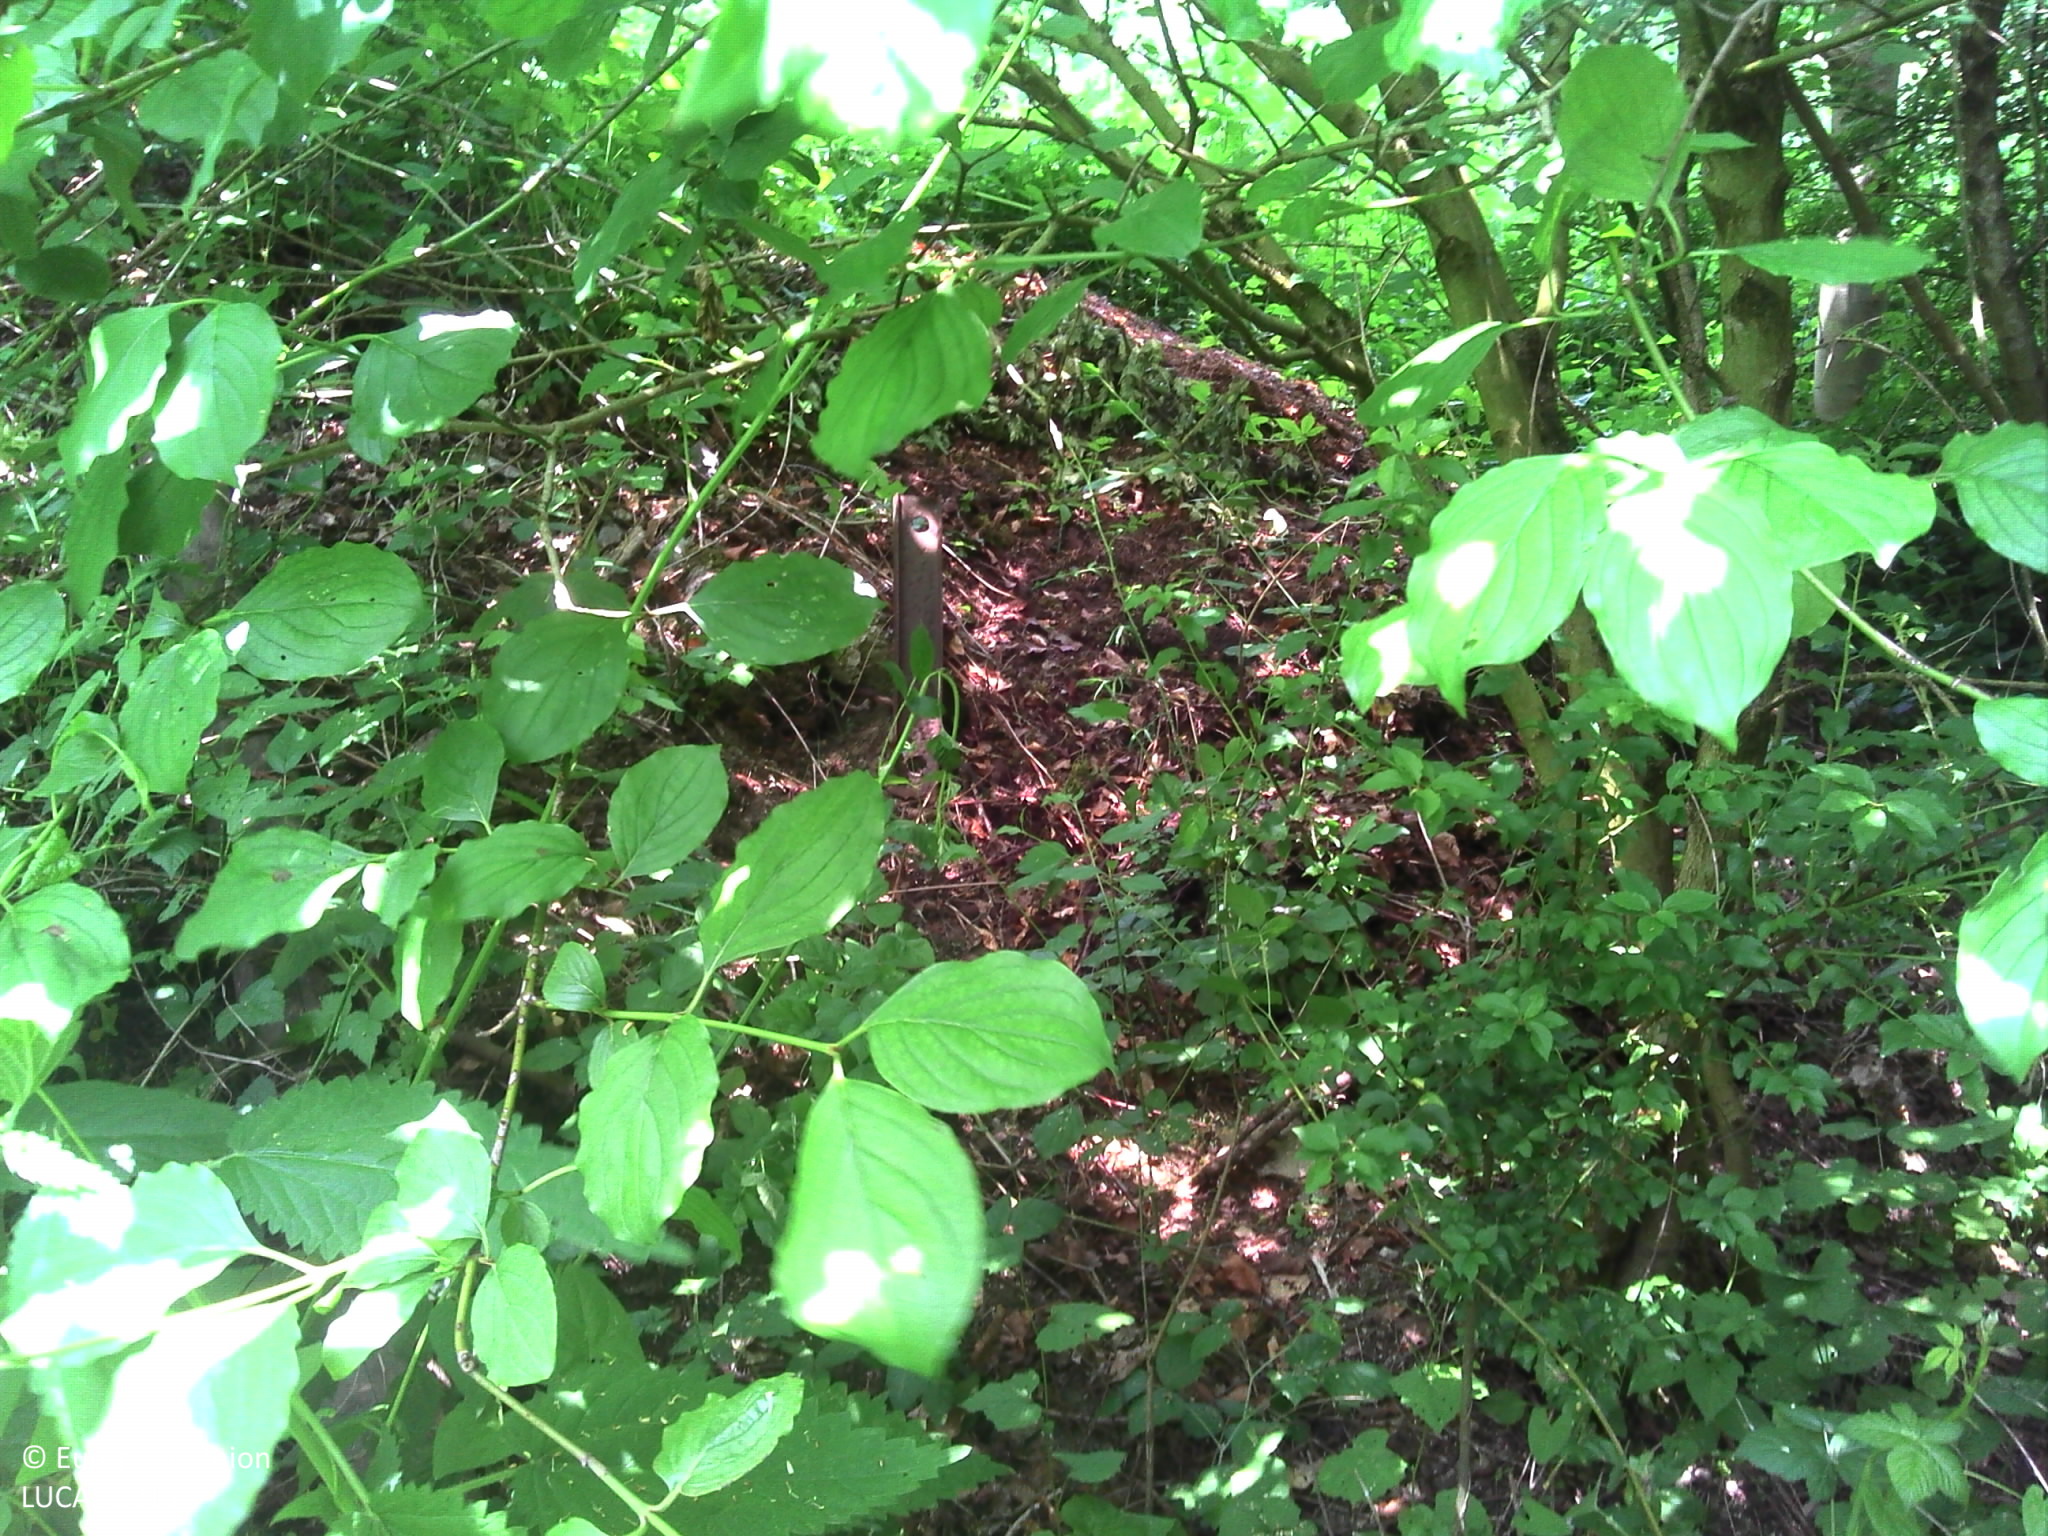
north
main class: Woodland
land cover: Broadleaved woodland
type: mesophytic deciduous forest
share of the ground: 50 - 75 %
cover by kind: broadleaved forest trees 65 %, shrubs 20 %, herbaceous plants 10 %, coniferous forest trees 5 %
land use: Forestry
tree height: > 5 m
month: June
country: BE
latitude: 50.3482
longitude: 5.5153
